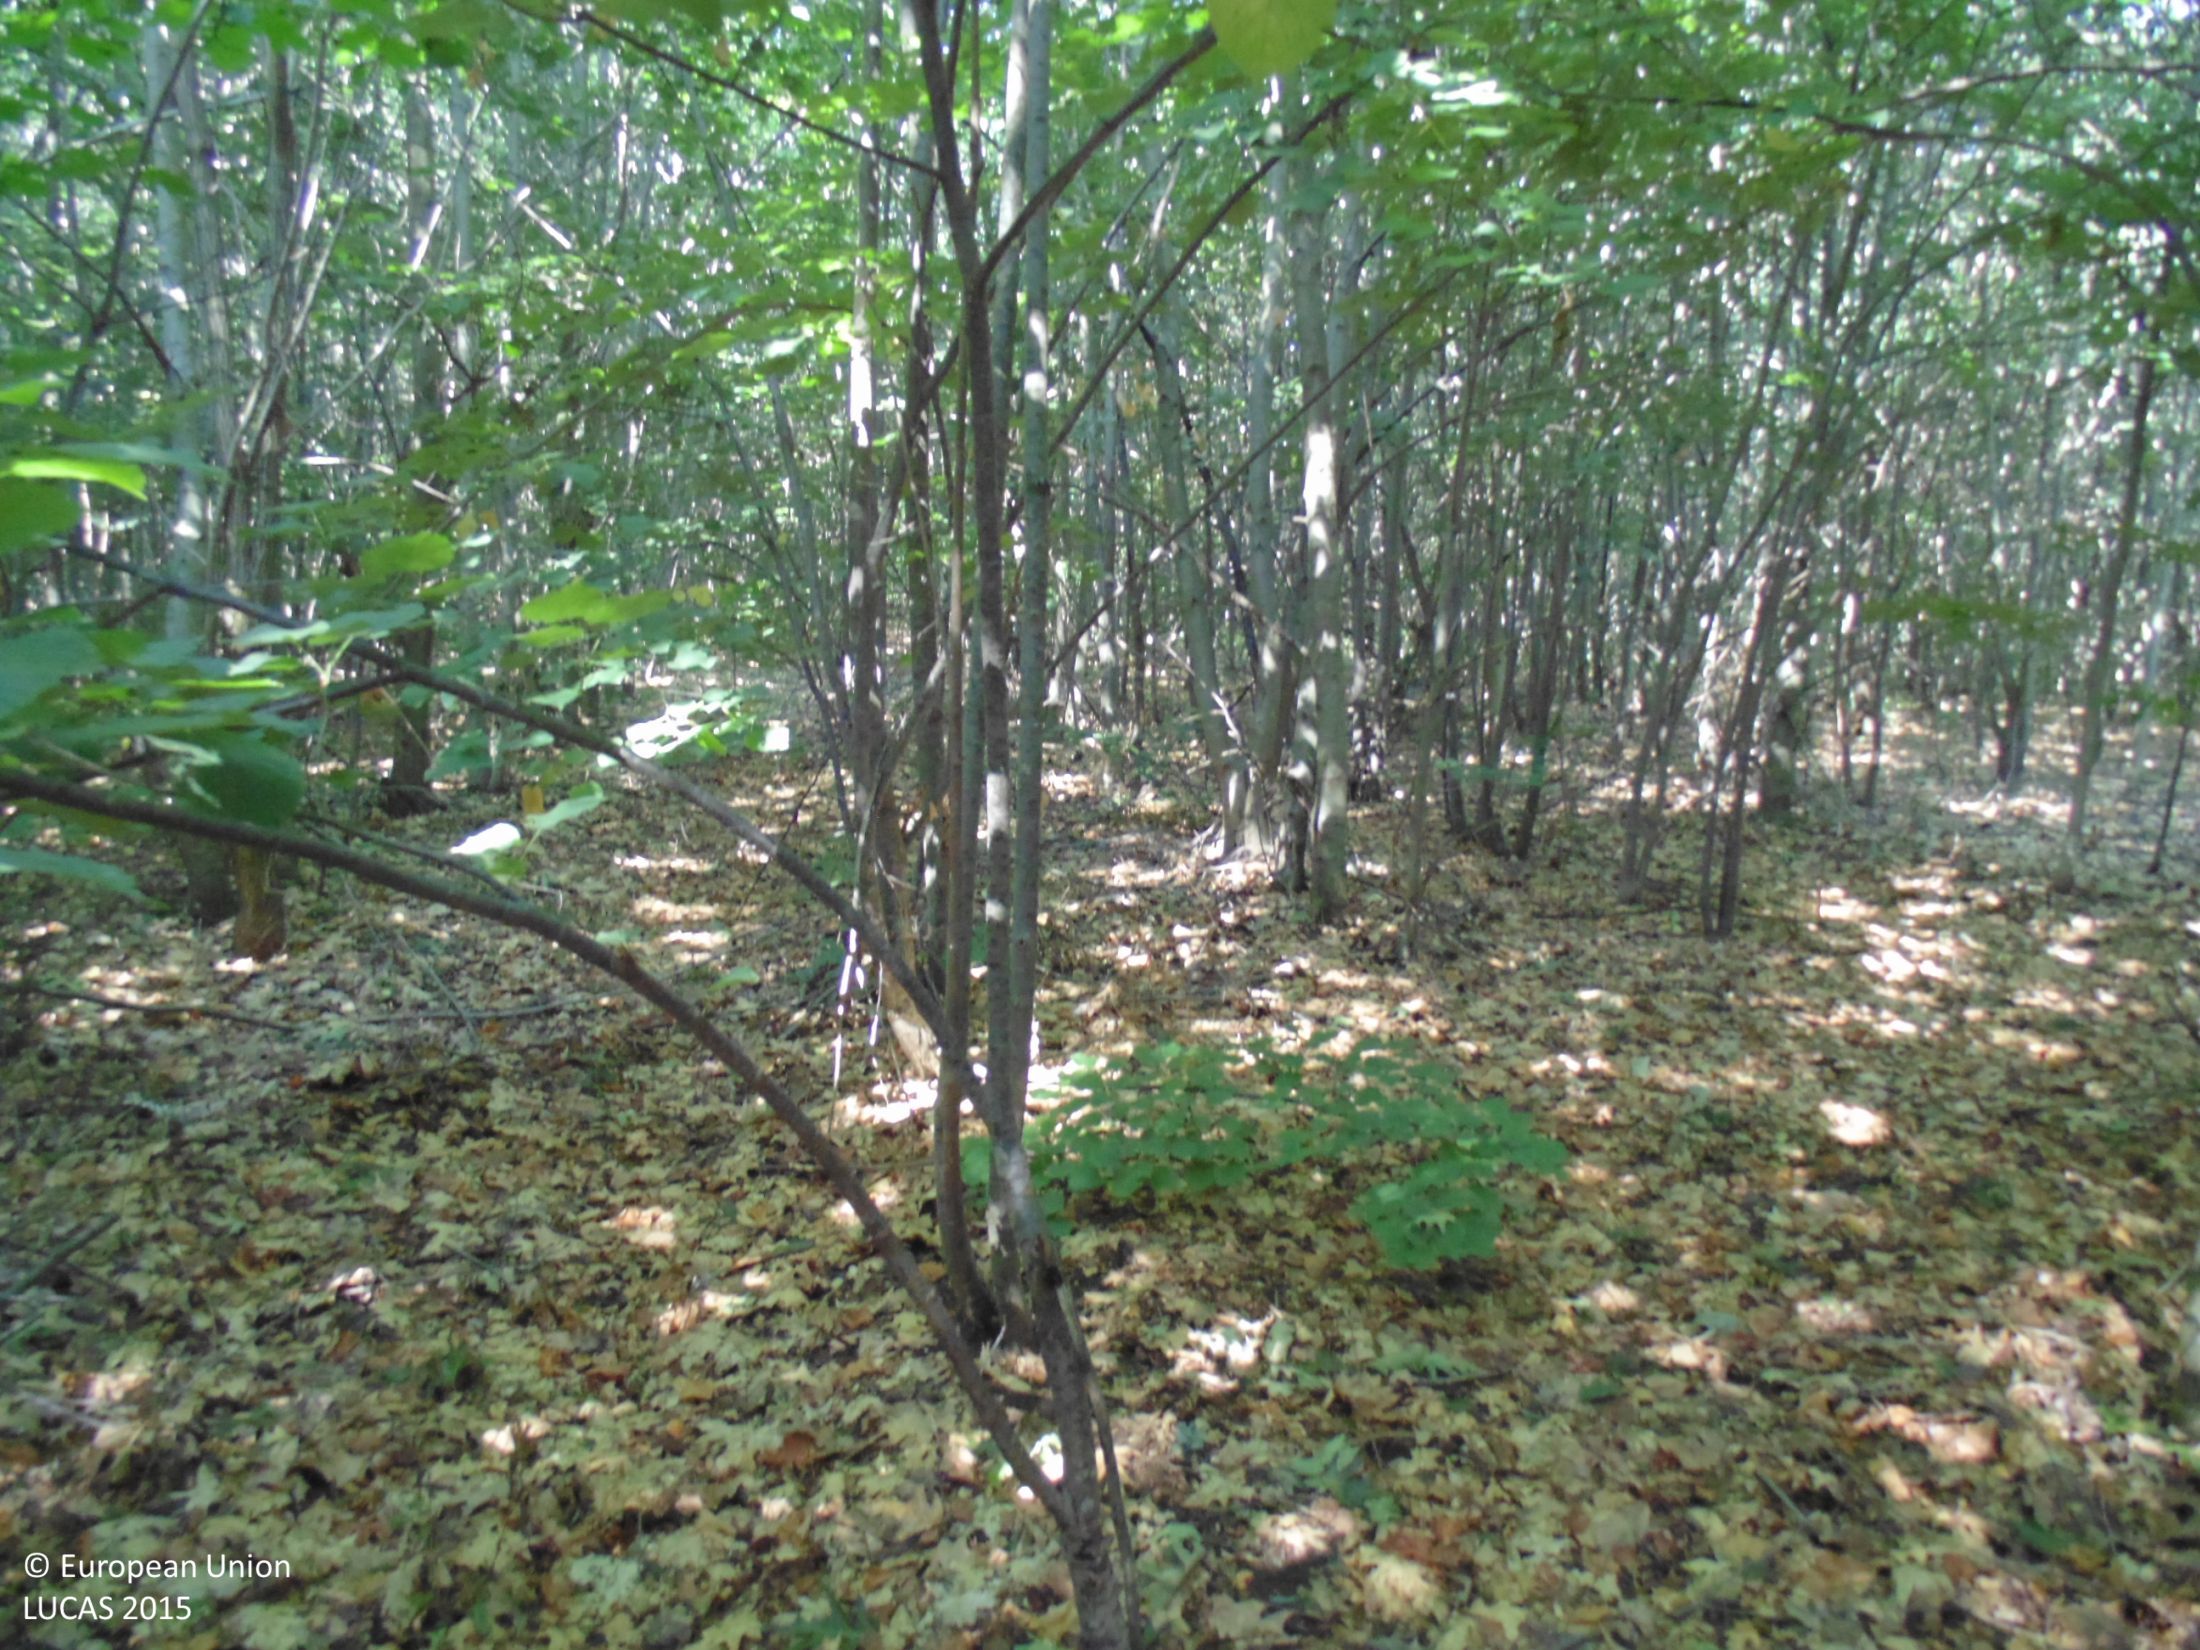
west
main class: Woodland
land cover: Broadleaved woodland
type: mesophytic deciduous forest
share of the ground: > 75 %
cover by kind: broadleaved forest trees 90 %, shrubs 5 %, unconsolidated bare surface 5 %
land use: Forestry
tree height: > 5 m
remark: Clear cut
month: August
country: BG
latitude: 43.6897
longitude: 27.5407
